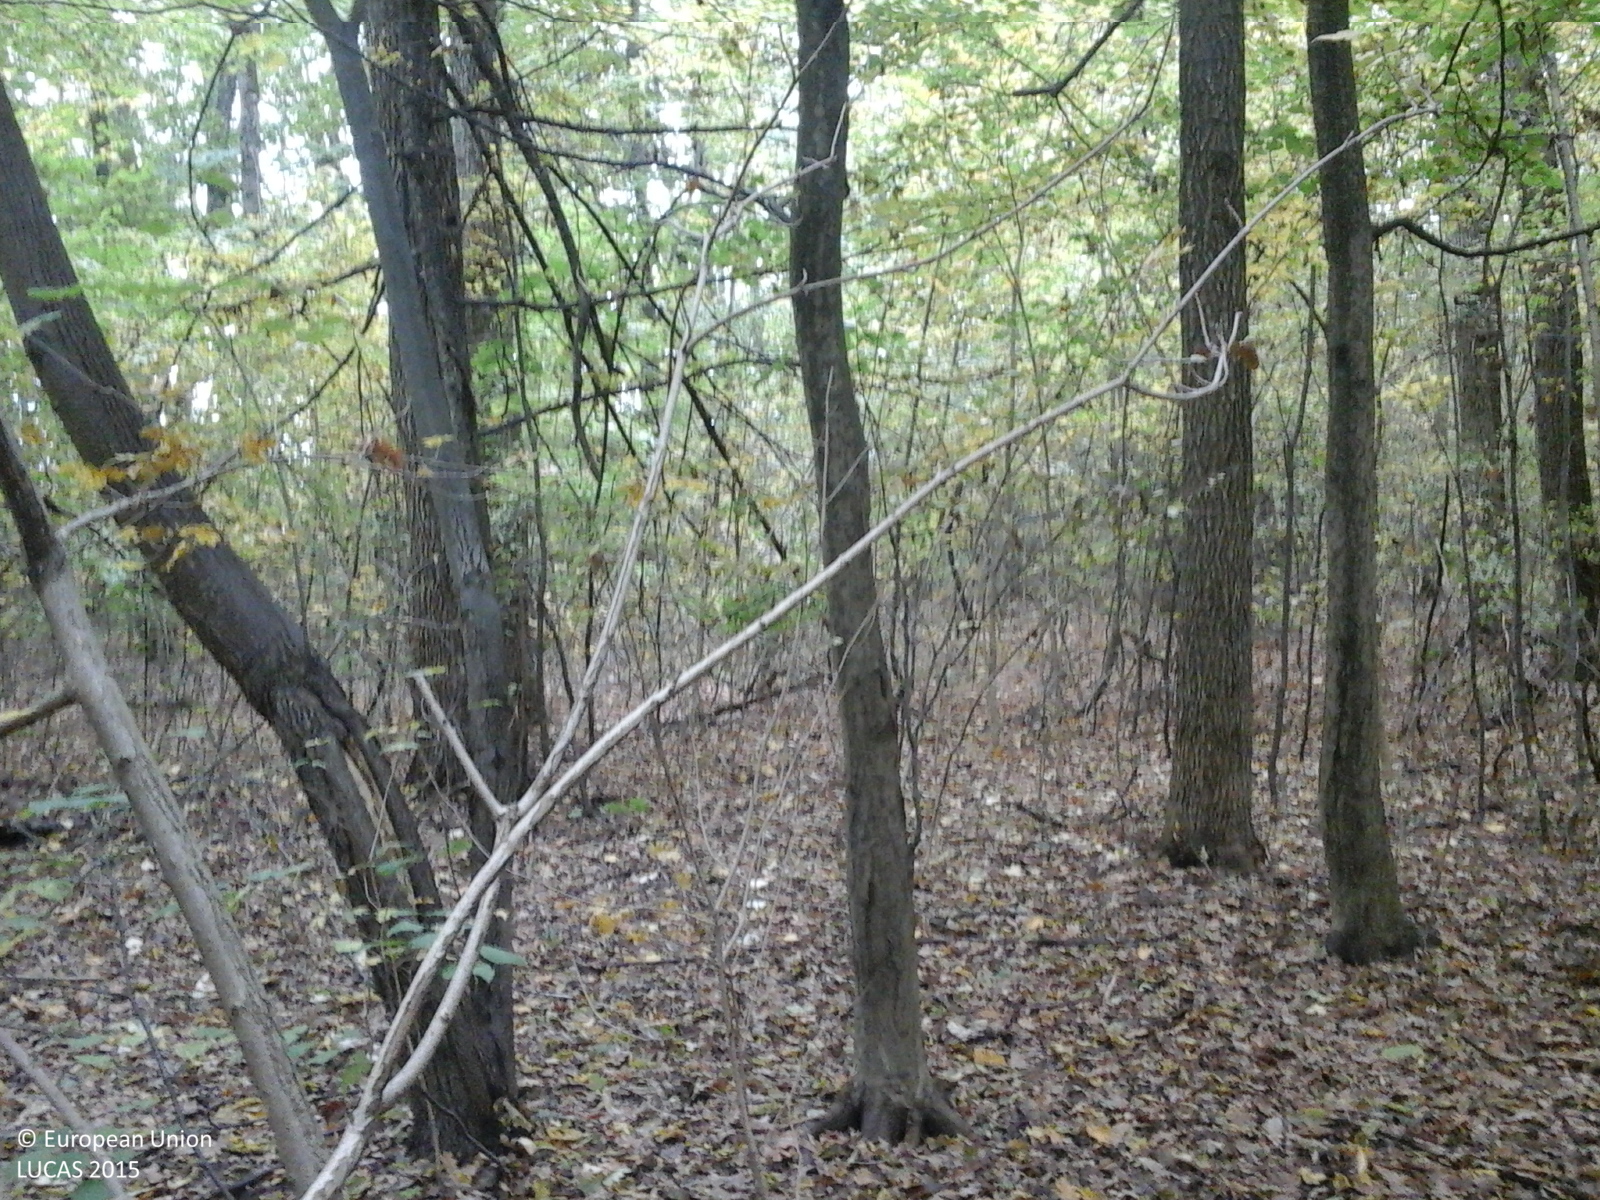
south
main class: Woodland
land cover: Broadleaved woodland
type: beech forest
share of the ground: > 75 %
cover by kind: broadleaved forest trees 100 %
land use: Forestry
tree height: > 5 m
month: October
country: RO
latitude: 44.7287
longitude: 26.0282
